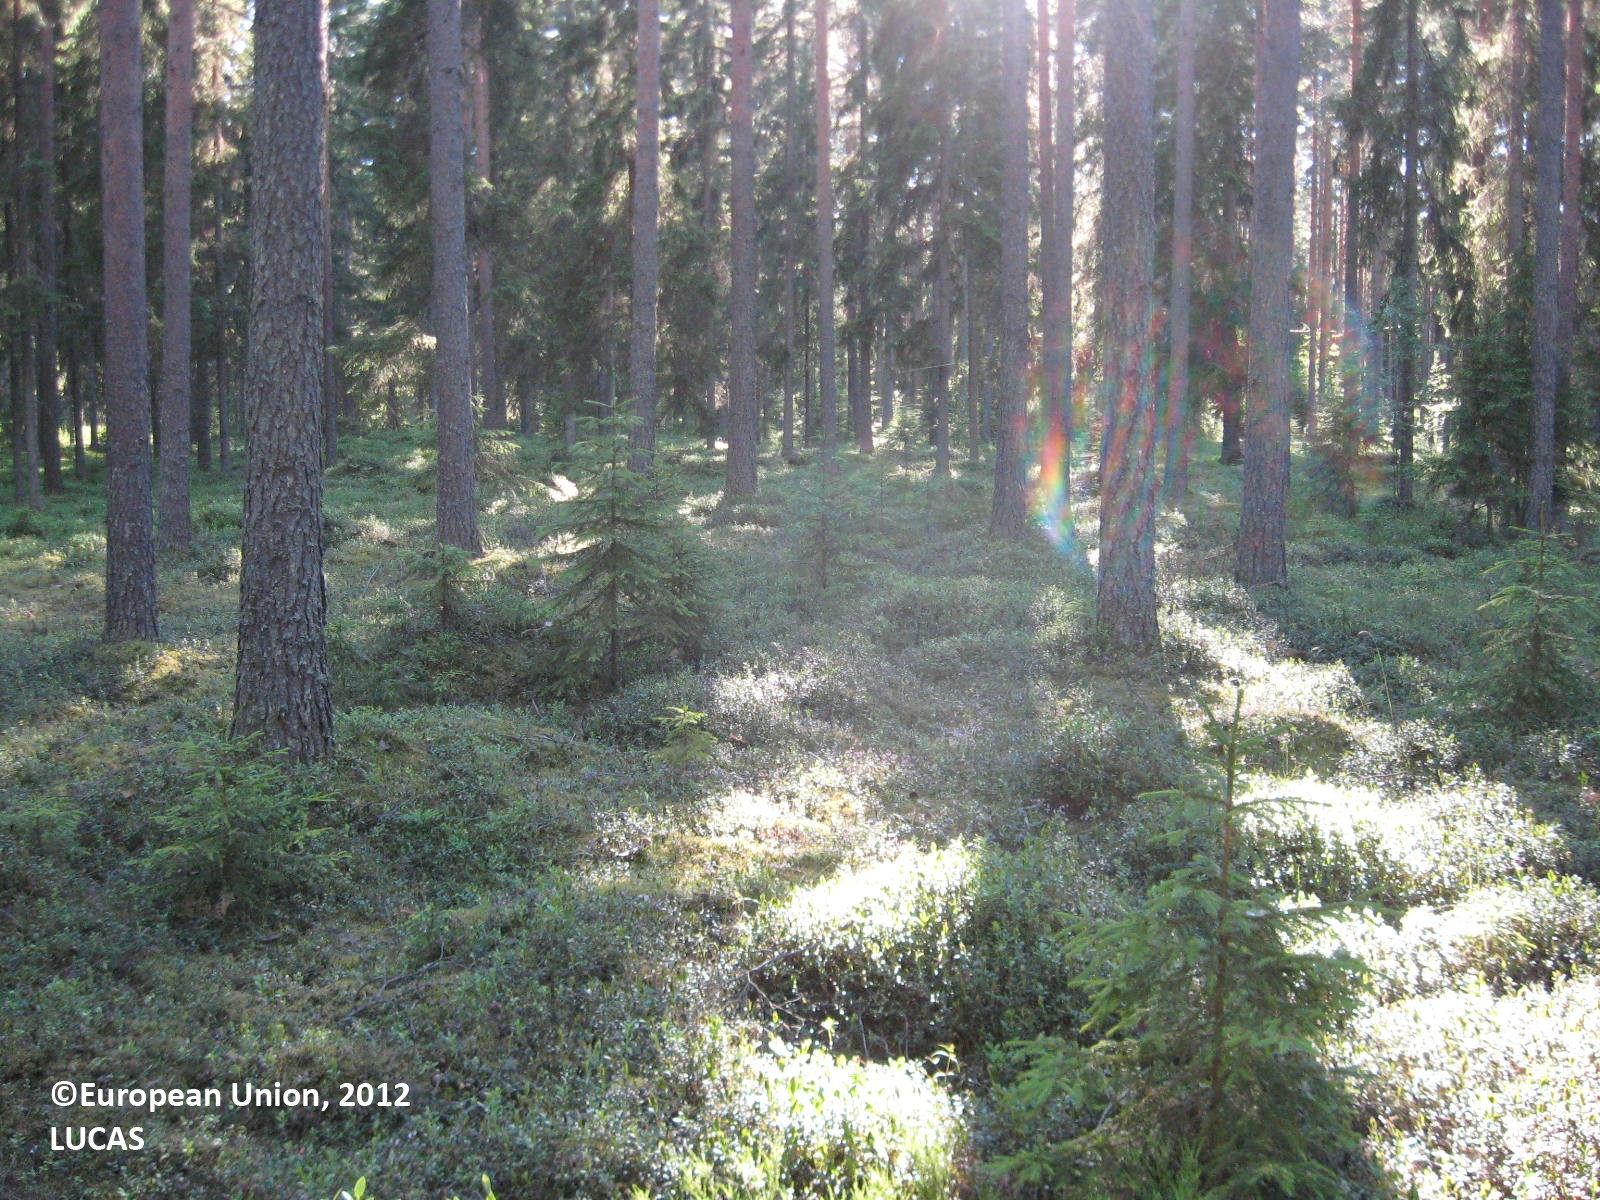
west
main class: Woodland
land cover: Other coniferous woodland
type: boreal forest
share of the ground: > 75 %
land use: Forestry
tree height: > 5 m
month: July
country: FI
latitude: 62.7476
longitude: 22.7218
